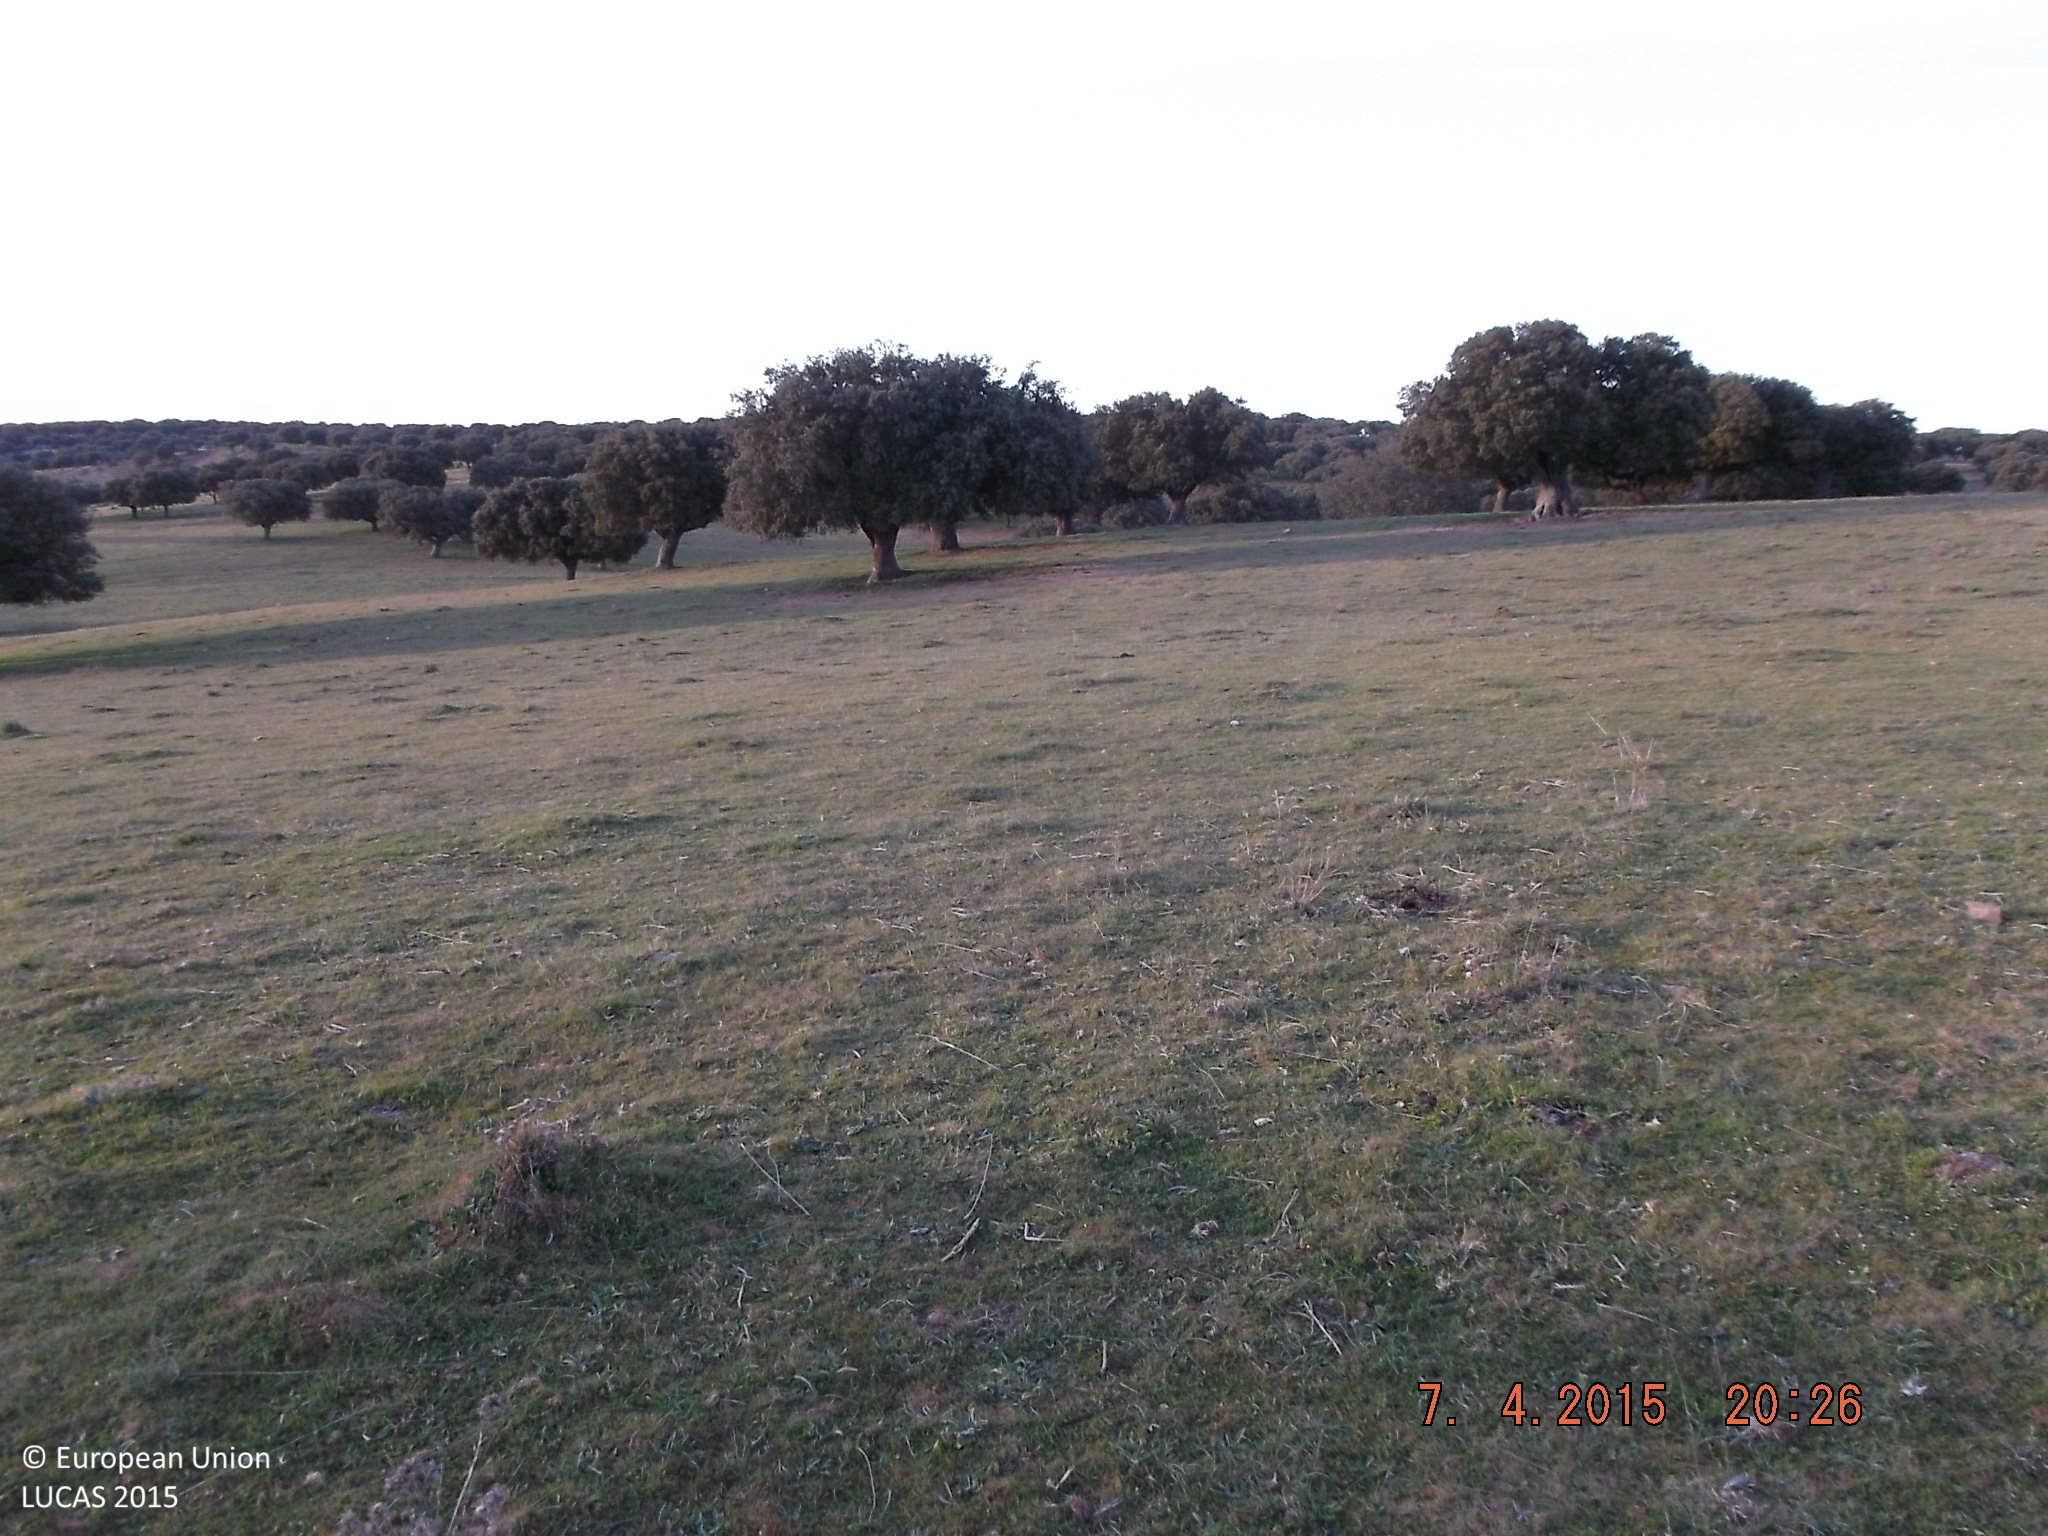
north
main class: Grassland
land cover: Grassland without tree/shrub cover
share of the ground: > 75 %
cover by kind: herbaceous plants 100 %
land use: Agriculture (excluding fallow land and kitchen gardens)
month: April
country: ES
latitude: 40.7862
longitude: -5.8752
